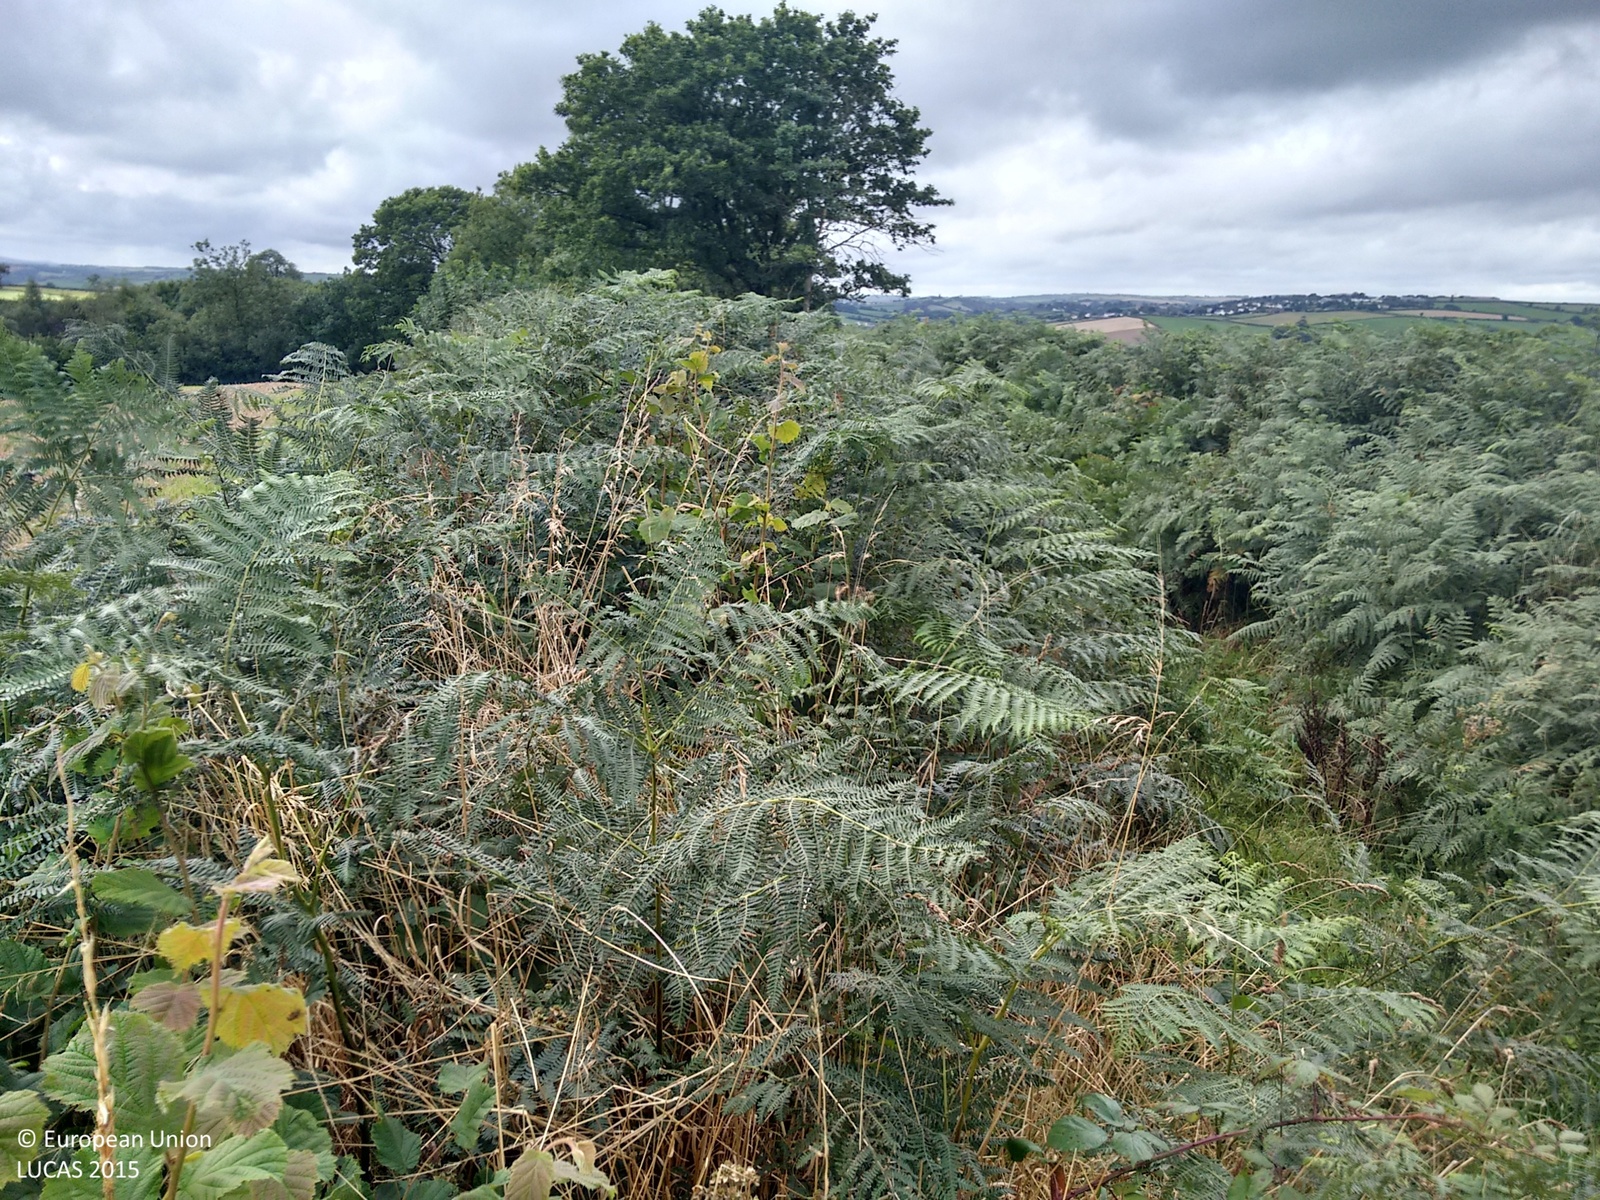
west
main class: Cropland
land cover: Barley
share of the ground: > 75 %
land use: Agriculture (excluding fallow land and kitchen gardens)
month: August
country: GB
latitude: 50.8581
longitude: -3.7701
